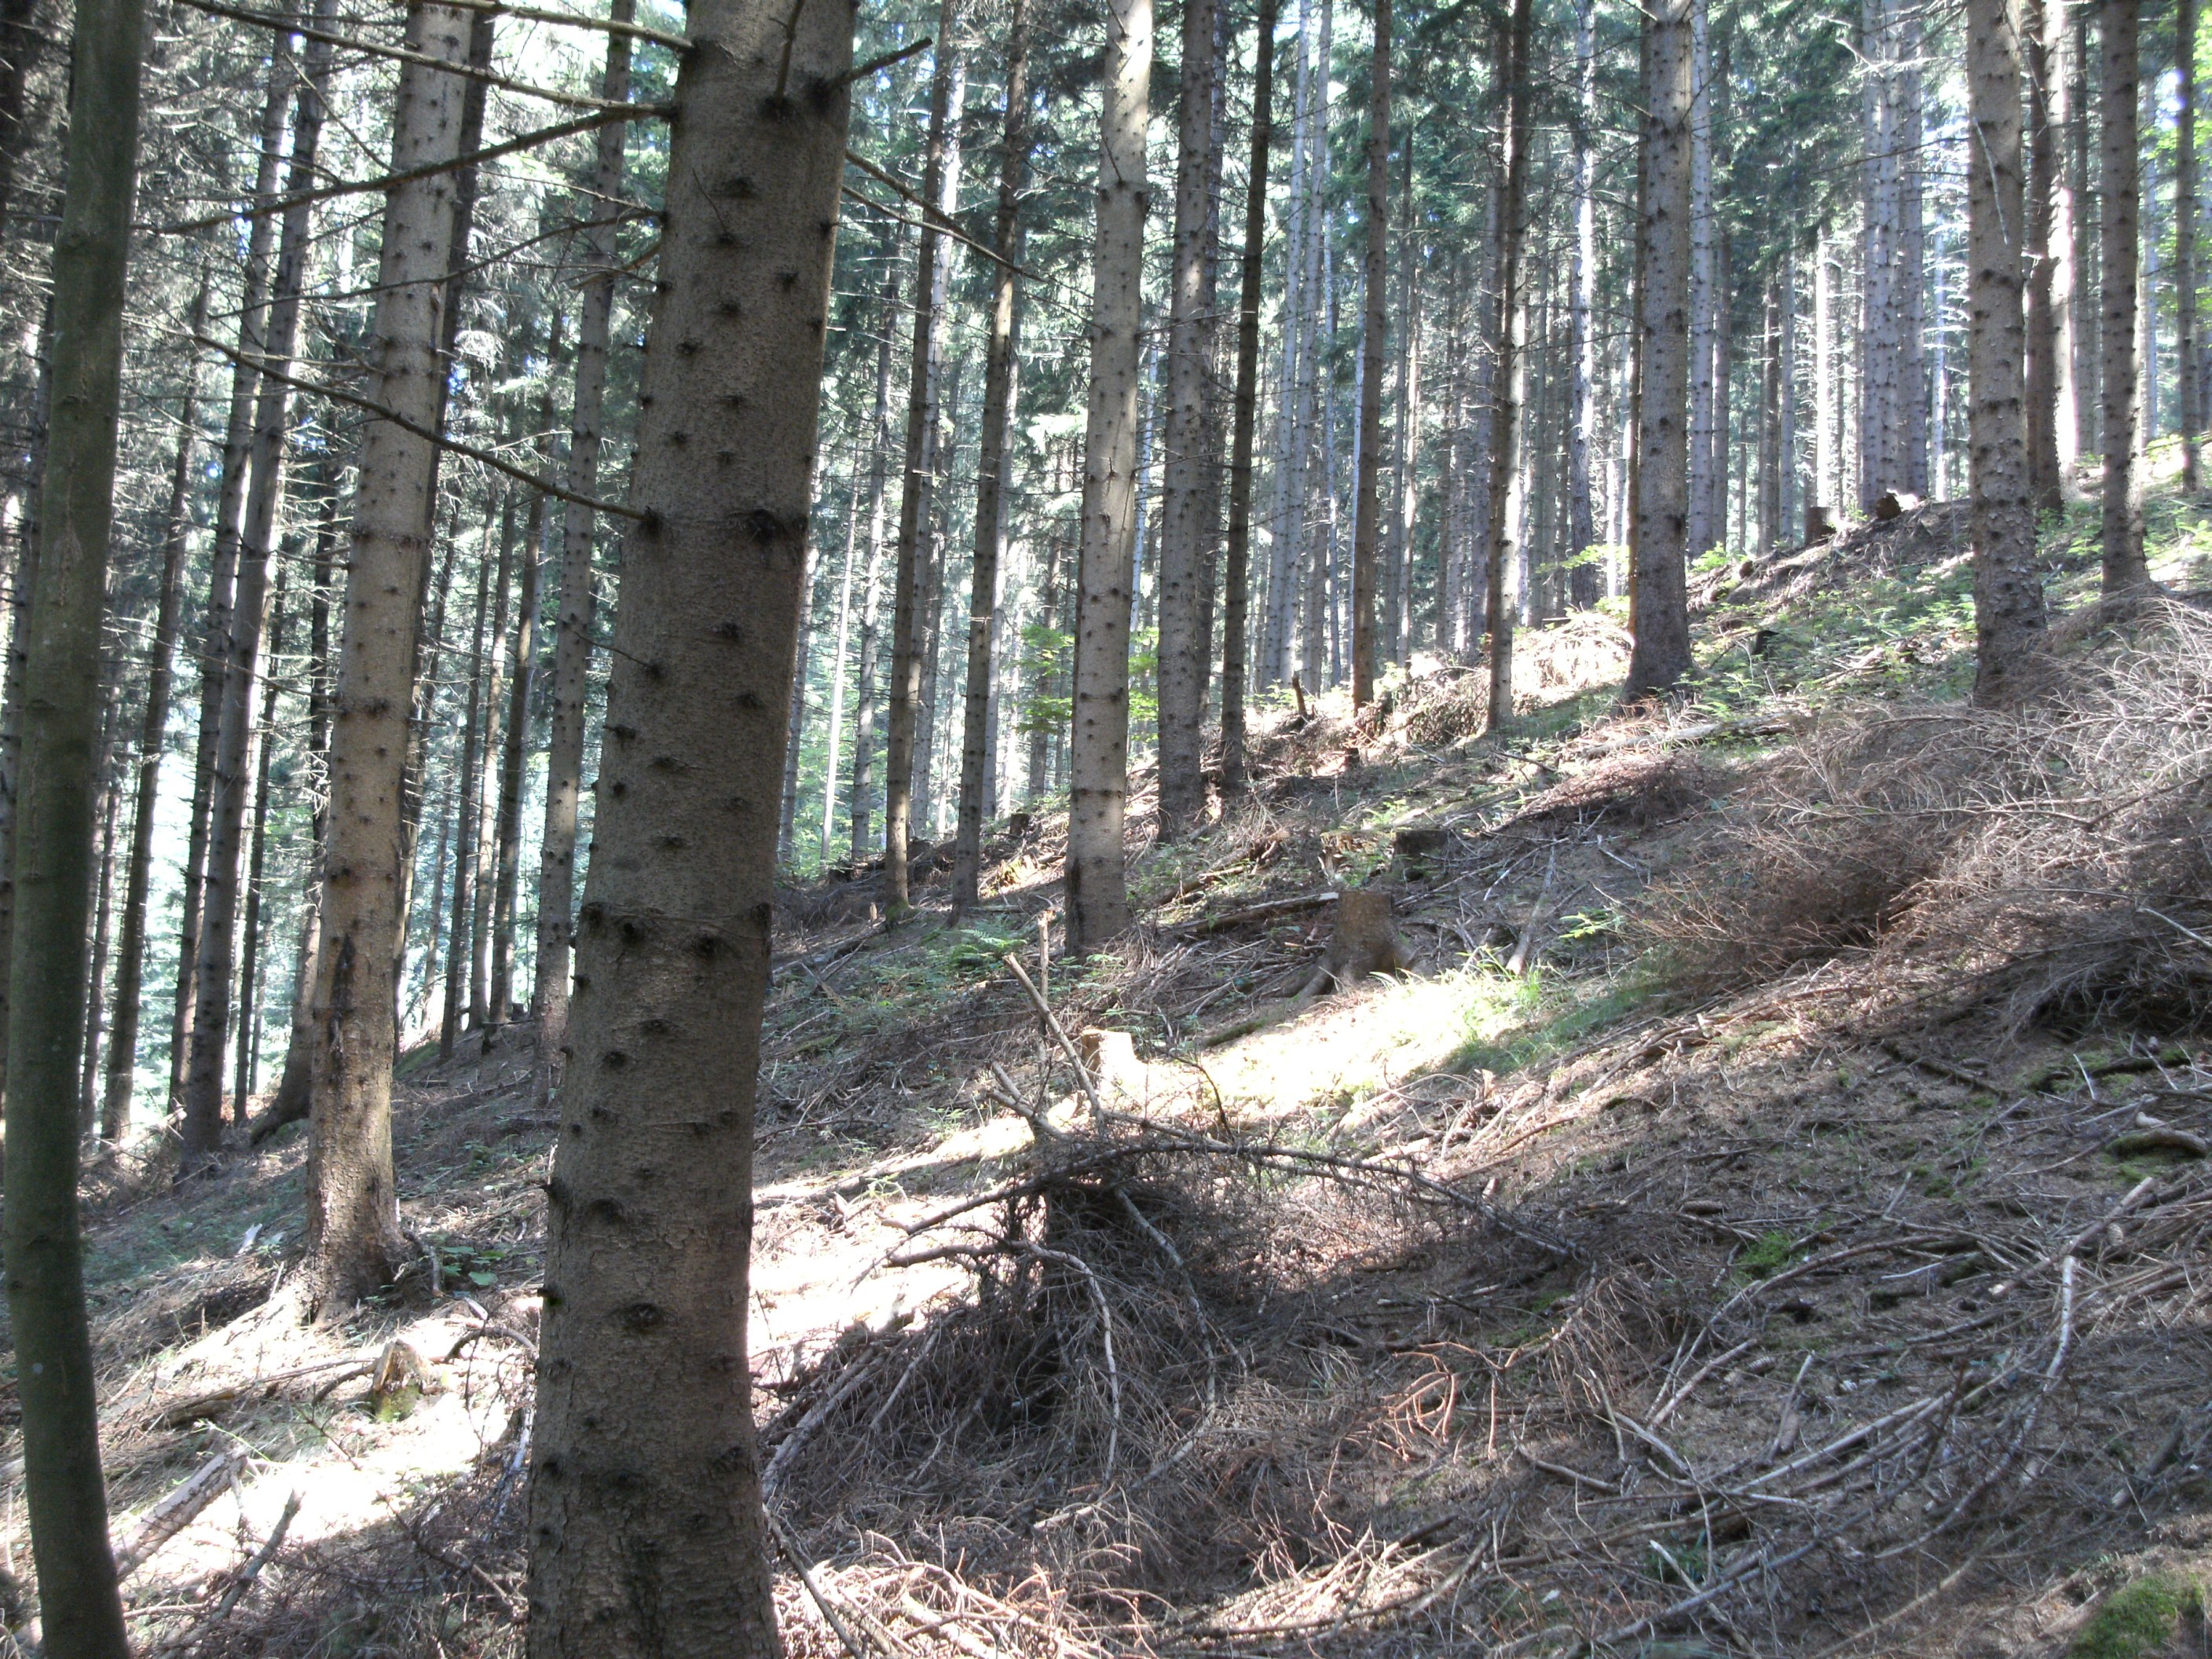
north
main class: Woodland
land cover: Spruce dominated coniferous woodland
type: alpine coniferous forest
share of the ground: > 75 %
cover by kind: coniferous forest trees 75 %, unconsolidated bare surface 10 %, broadleaved forest trees 5 %, shrubs 5 %, herbaceous plants 5 %
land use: Forestry
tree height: > 5 m
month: July
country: AT
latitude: 46.8348
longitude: 14.8888
